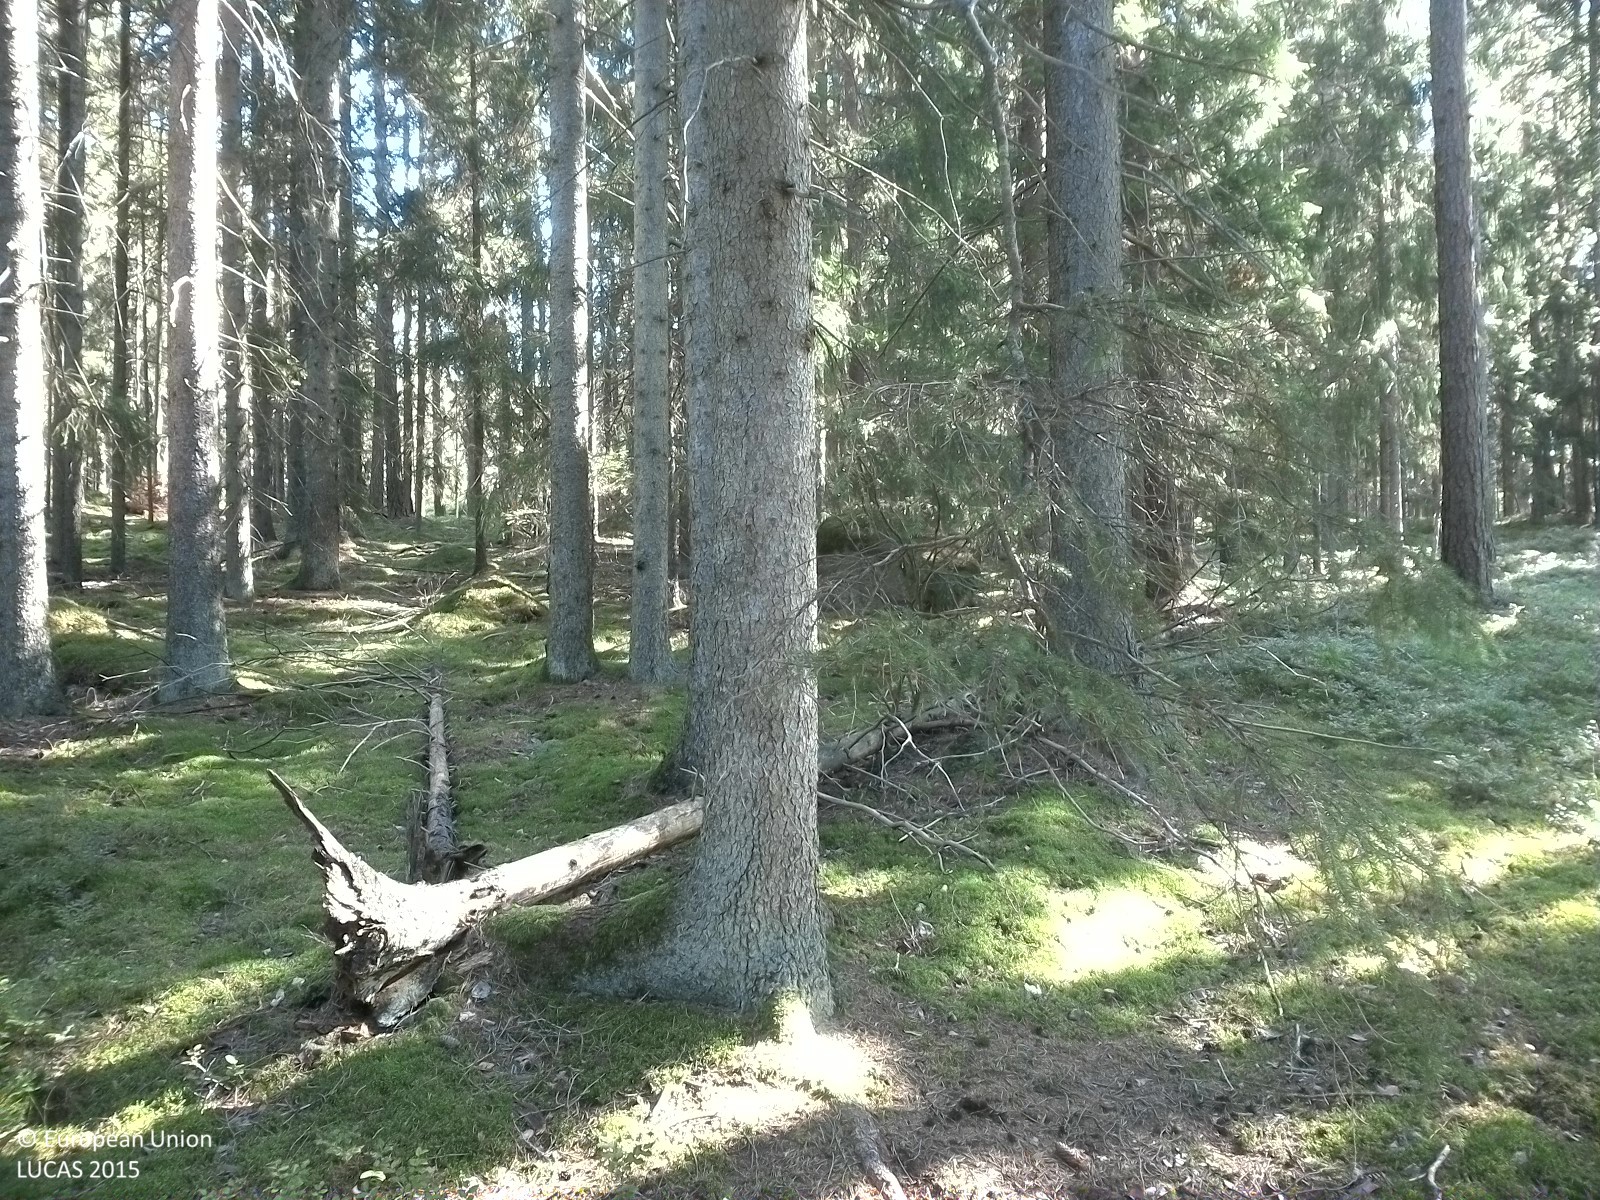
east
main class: Woodland
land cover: Spruce dominated coniferous woodland
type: boreal forest
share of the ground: 50 - 75 %
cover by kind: coniferous forest trees 55 %, lichens and mosses 30 %, herbaceous plants 15 %
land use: Forestry
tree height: > 5 m
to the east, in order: Spruce dominated coniferous woodland; Pine dominated coniferous woodland; Spruce dominated coniferous woodland; Spruce dominated mixed woodland; Pine dominated mixed woodland; Tracks; Broadleaved woodland; Pine dominated mixed woodland
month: August
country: SE
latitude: 59.4011
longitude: 15.1518
